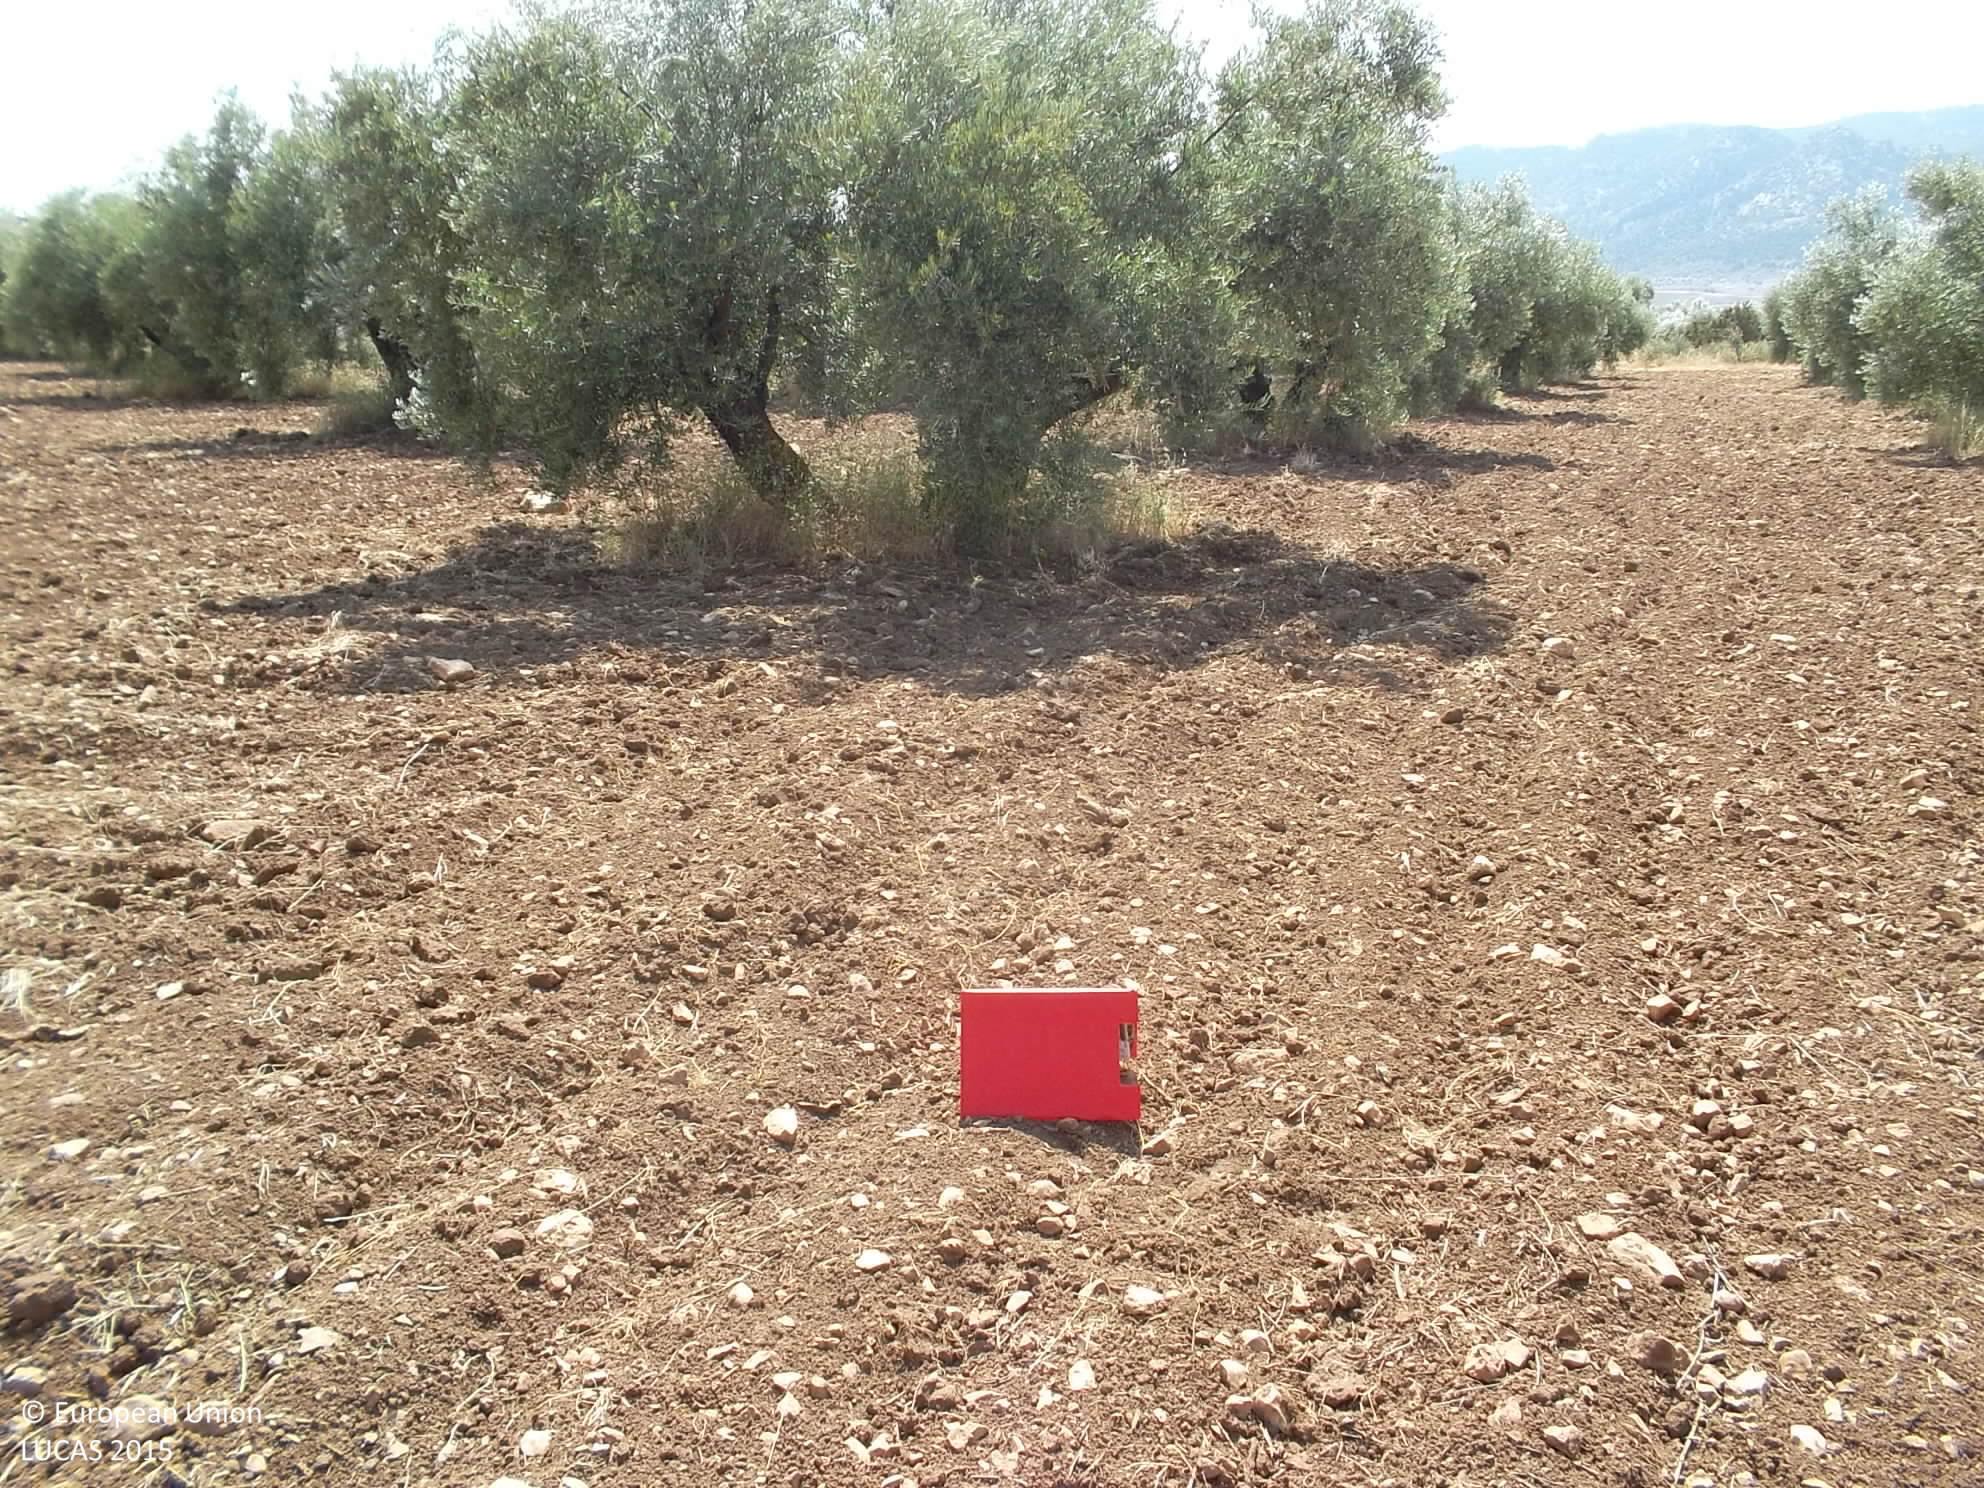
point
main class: Cropland
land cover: Olive groves
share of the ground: 50 - 75 %
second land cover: Other bare soil
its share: > 75 %
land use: Agriculture (excluding fallow land and kitchen gardens)
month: June
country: ES
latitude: 37.7457
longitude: -2.8954
